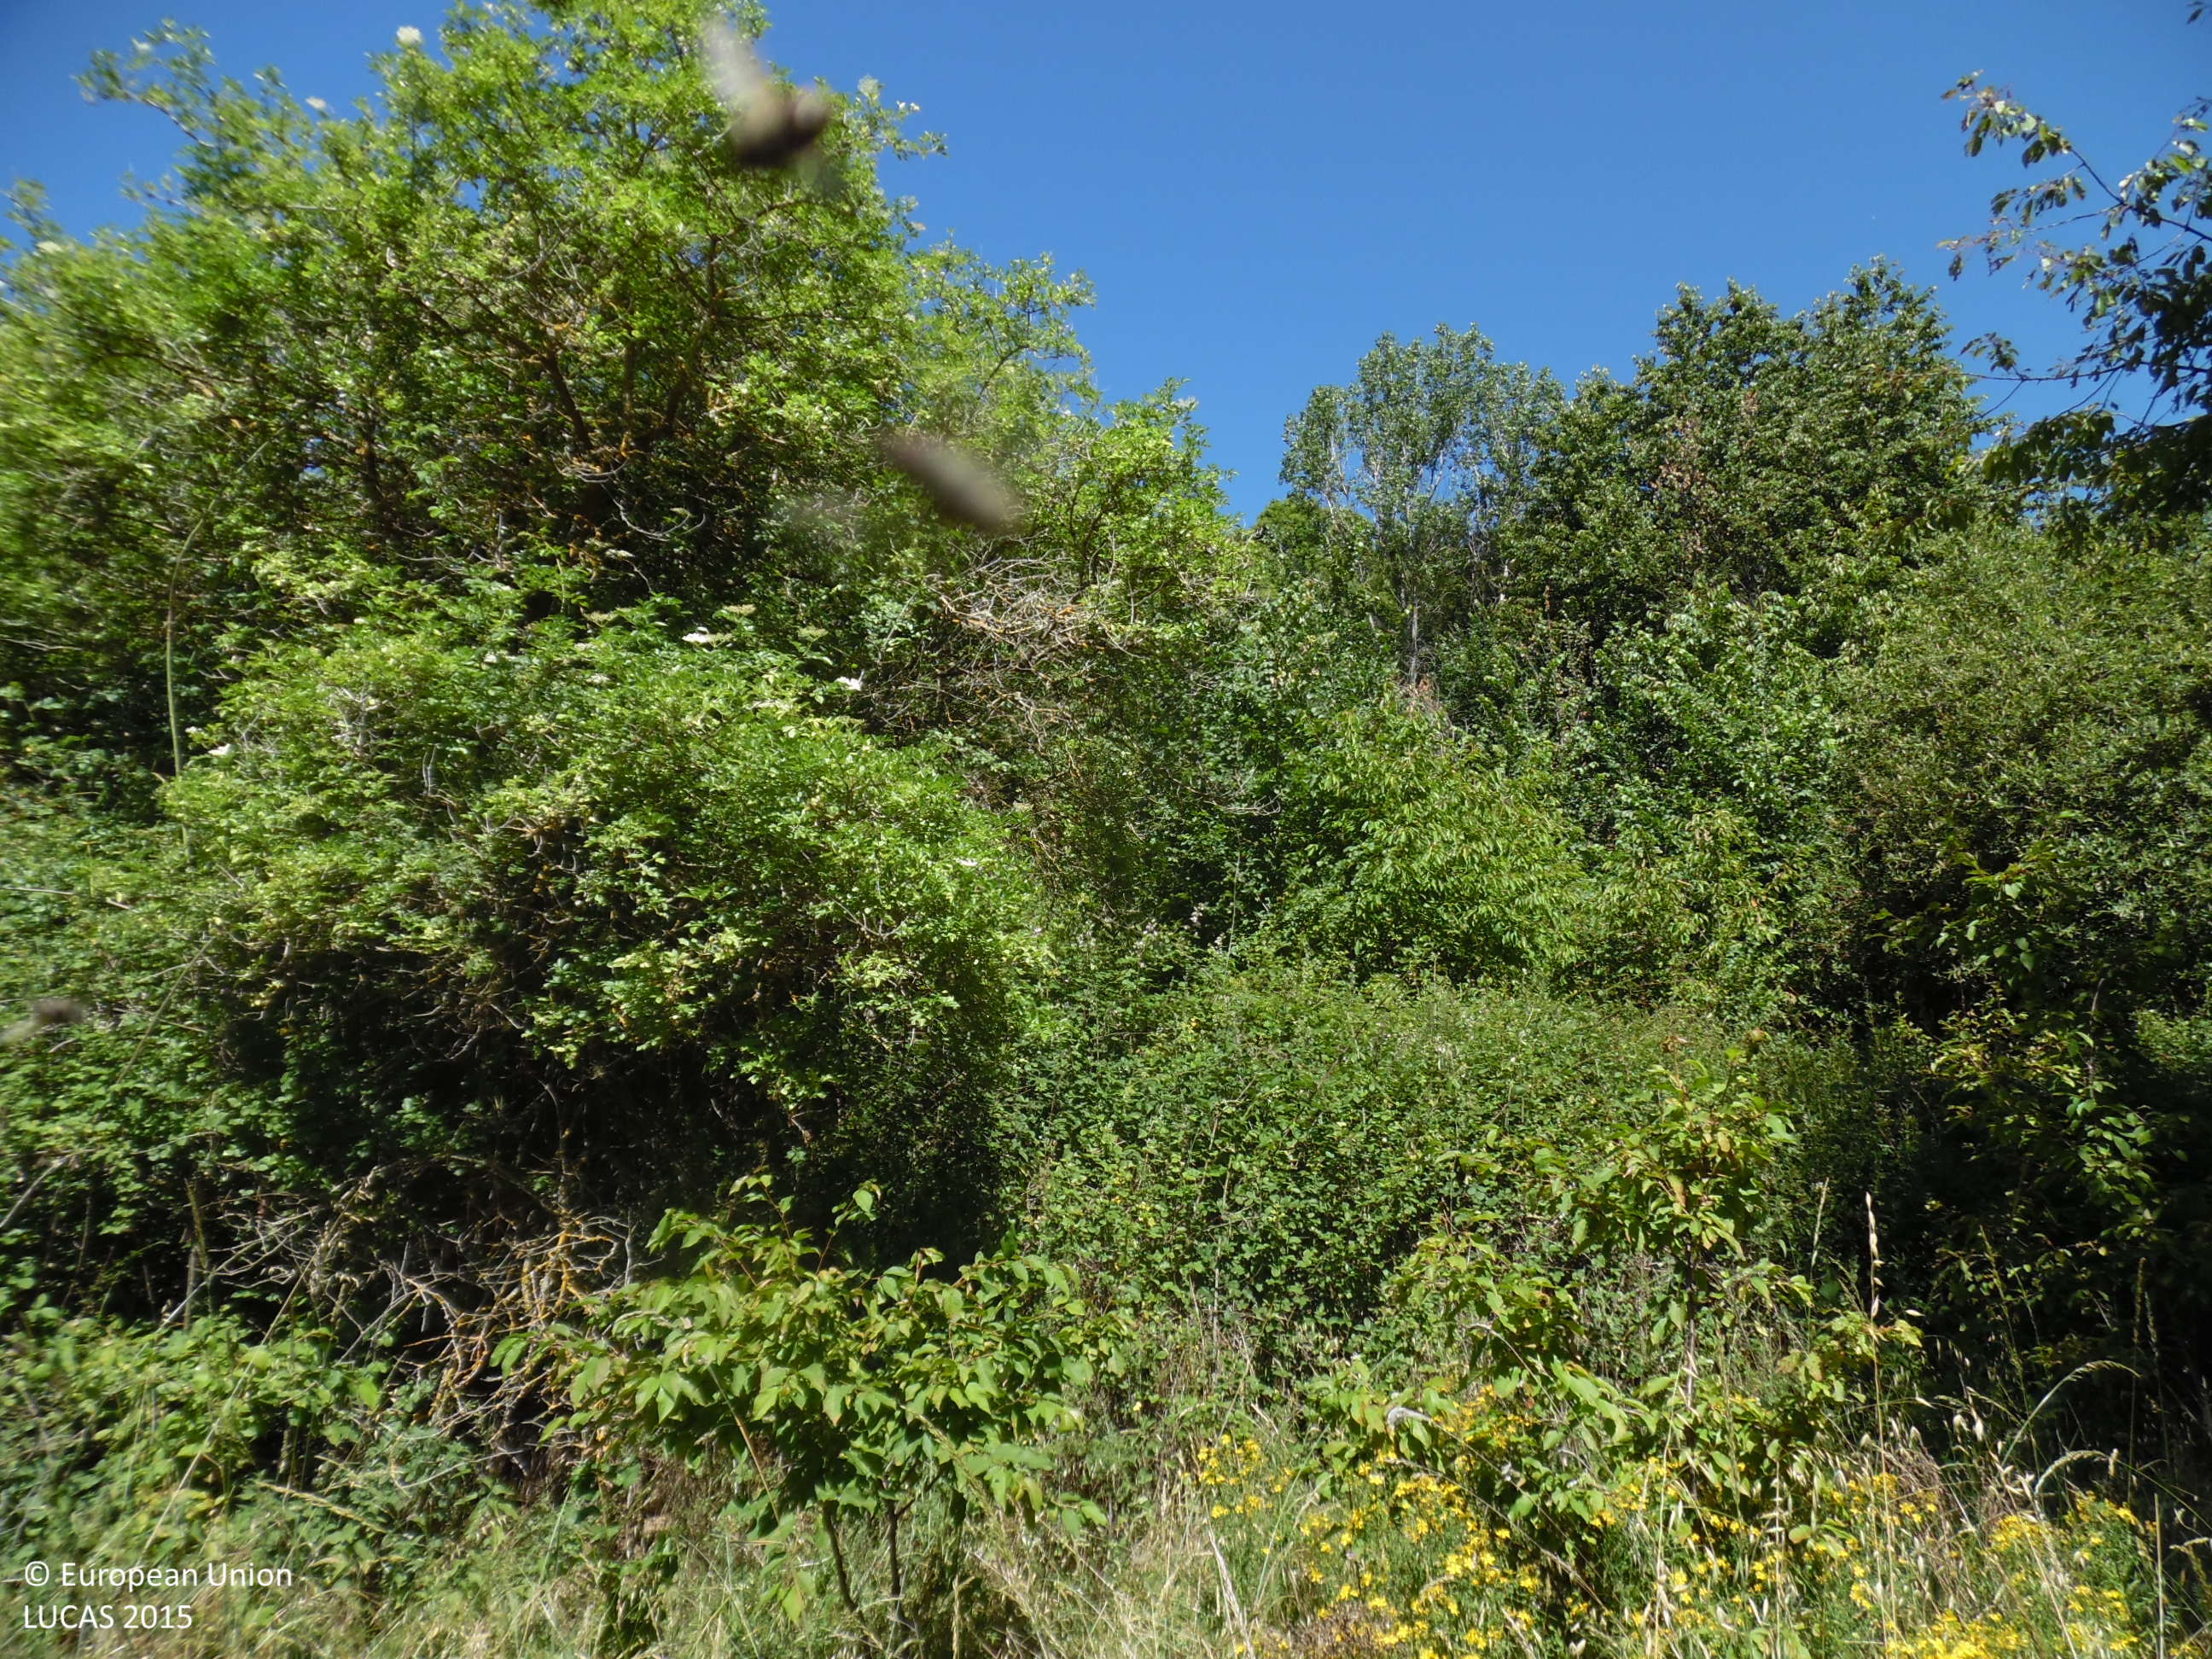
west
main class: Grassland
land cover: Grassland without tree/shrub cover
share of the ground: 50 - 75 %
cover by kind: herbaceous plants 95 %, shrubs 5 %
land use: Agriculture (excluding fallow land and kitchen gardens)
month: June
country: ES
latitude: 42.5695
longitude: -6.8771
